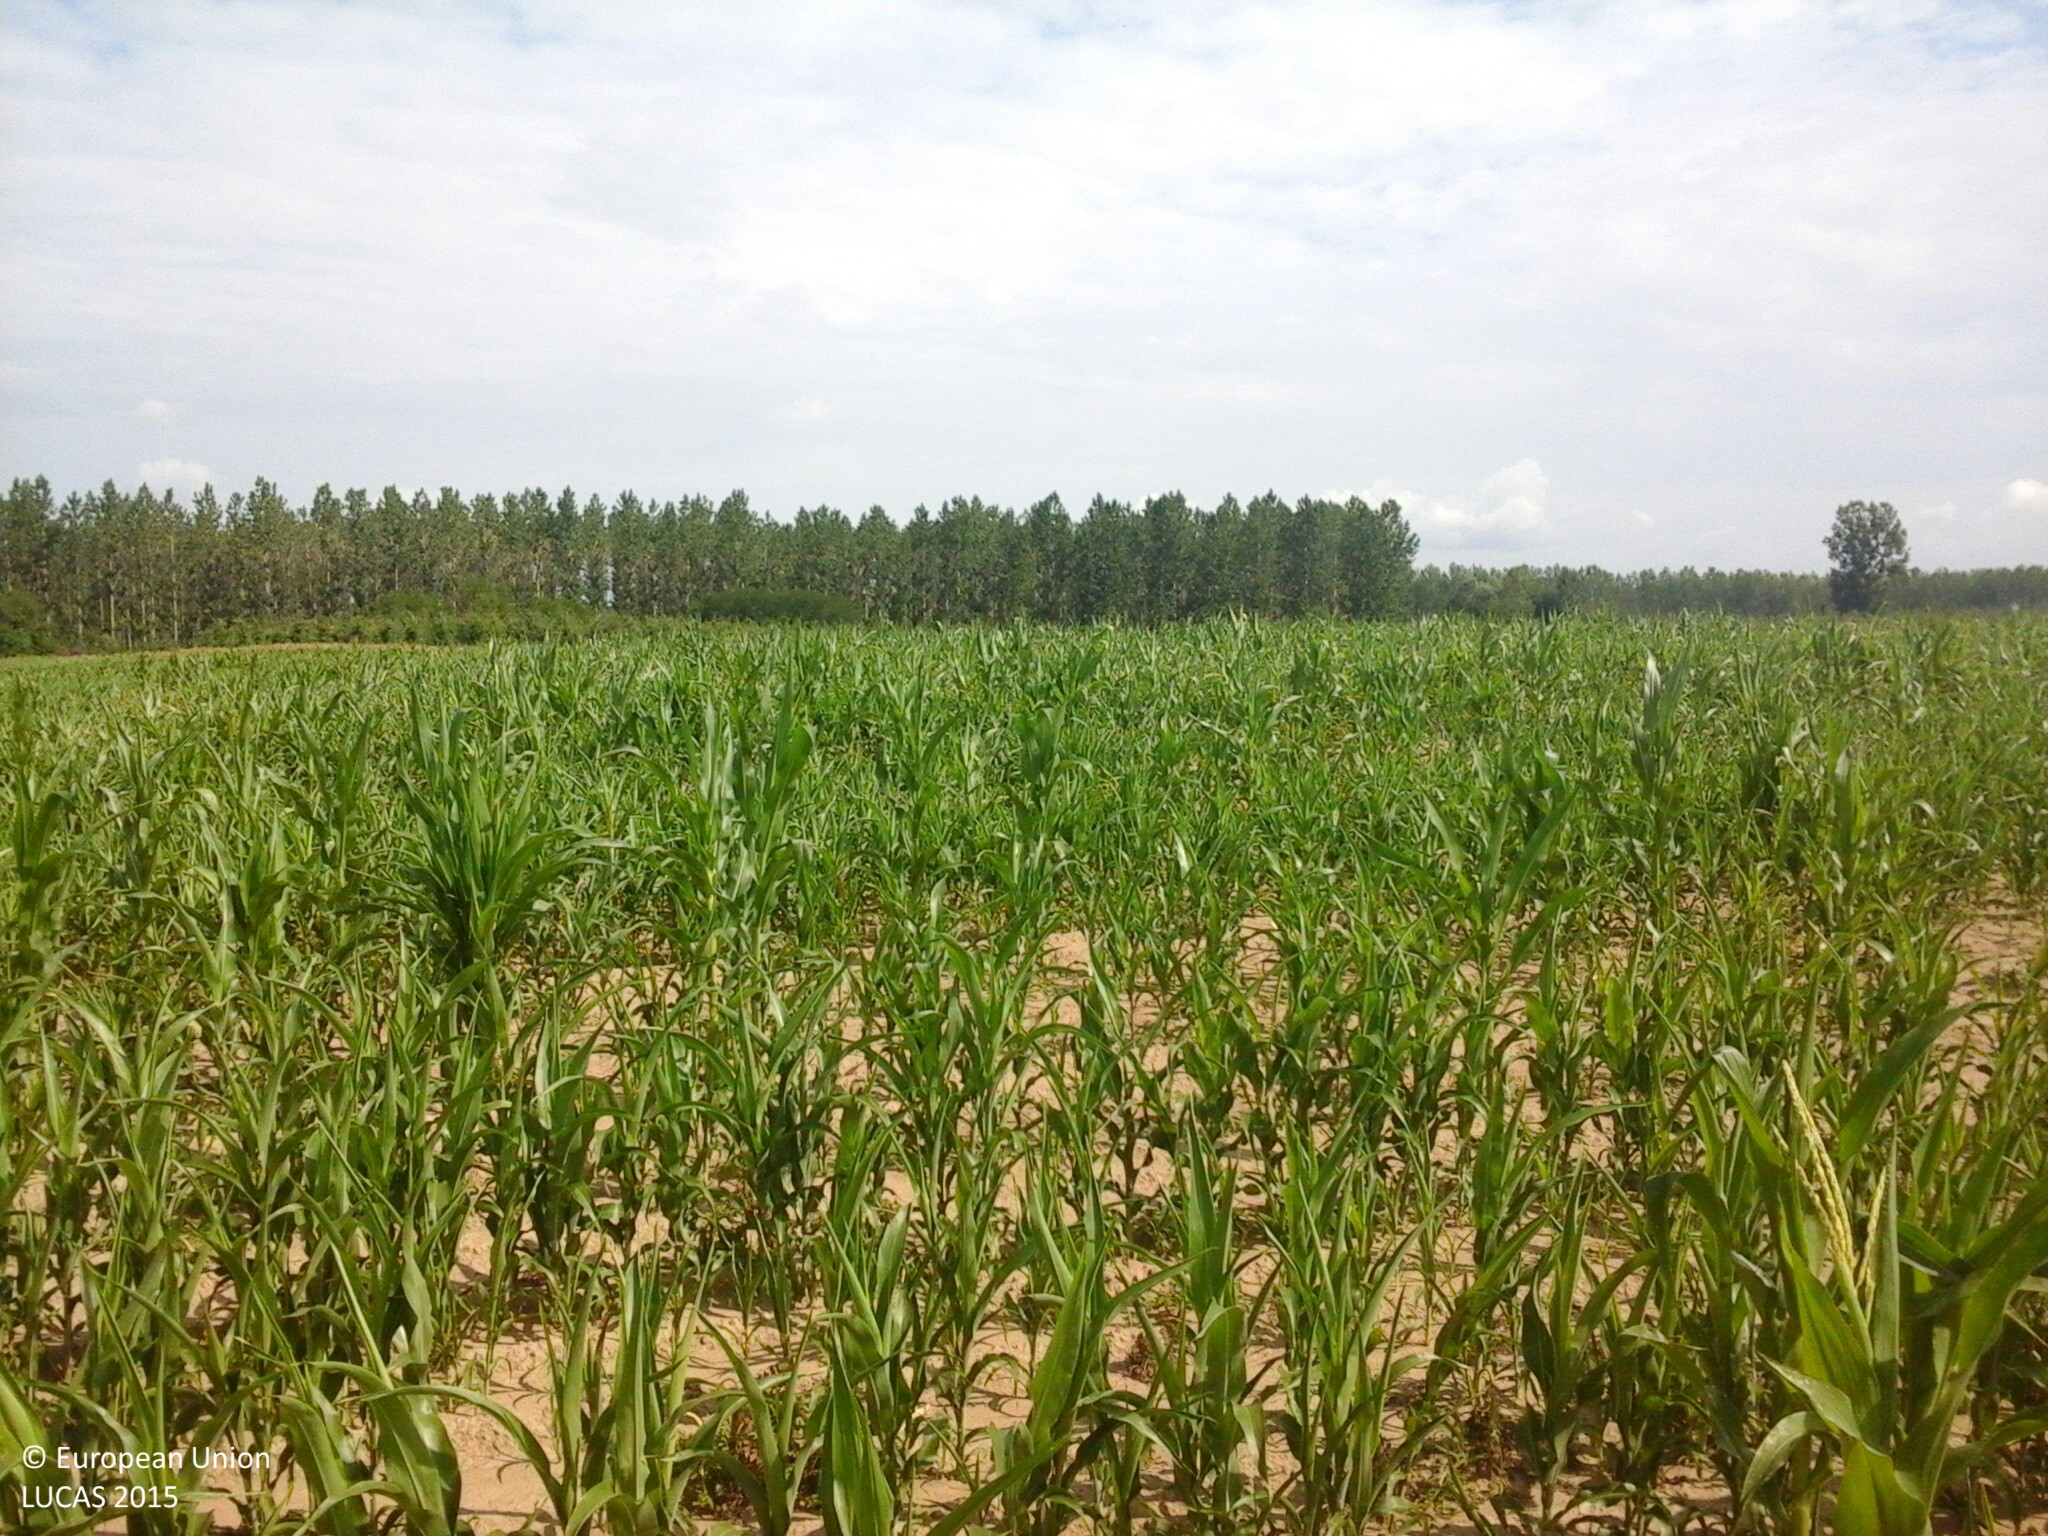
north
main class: Cropland
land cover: Maize
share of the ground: 50 - 75 %
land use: Agriculture (excluding fallow land and kitchen gardens)
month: July
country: HU
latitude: 48.3983
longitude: 22.1992
